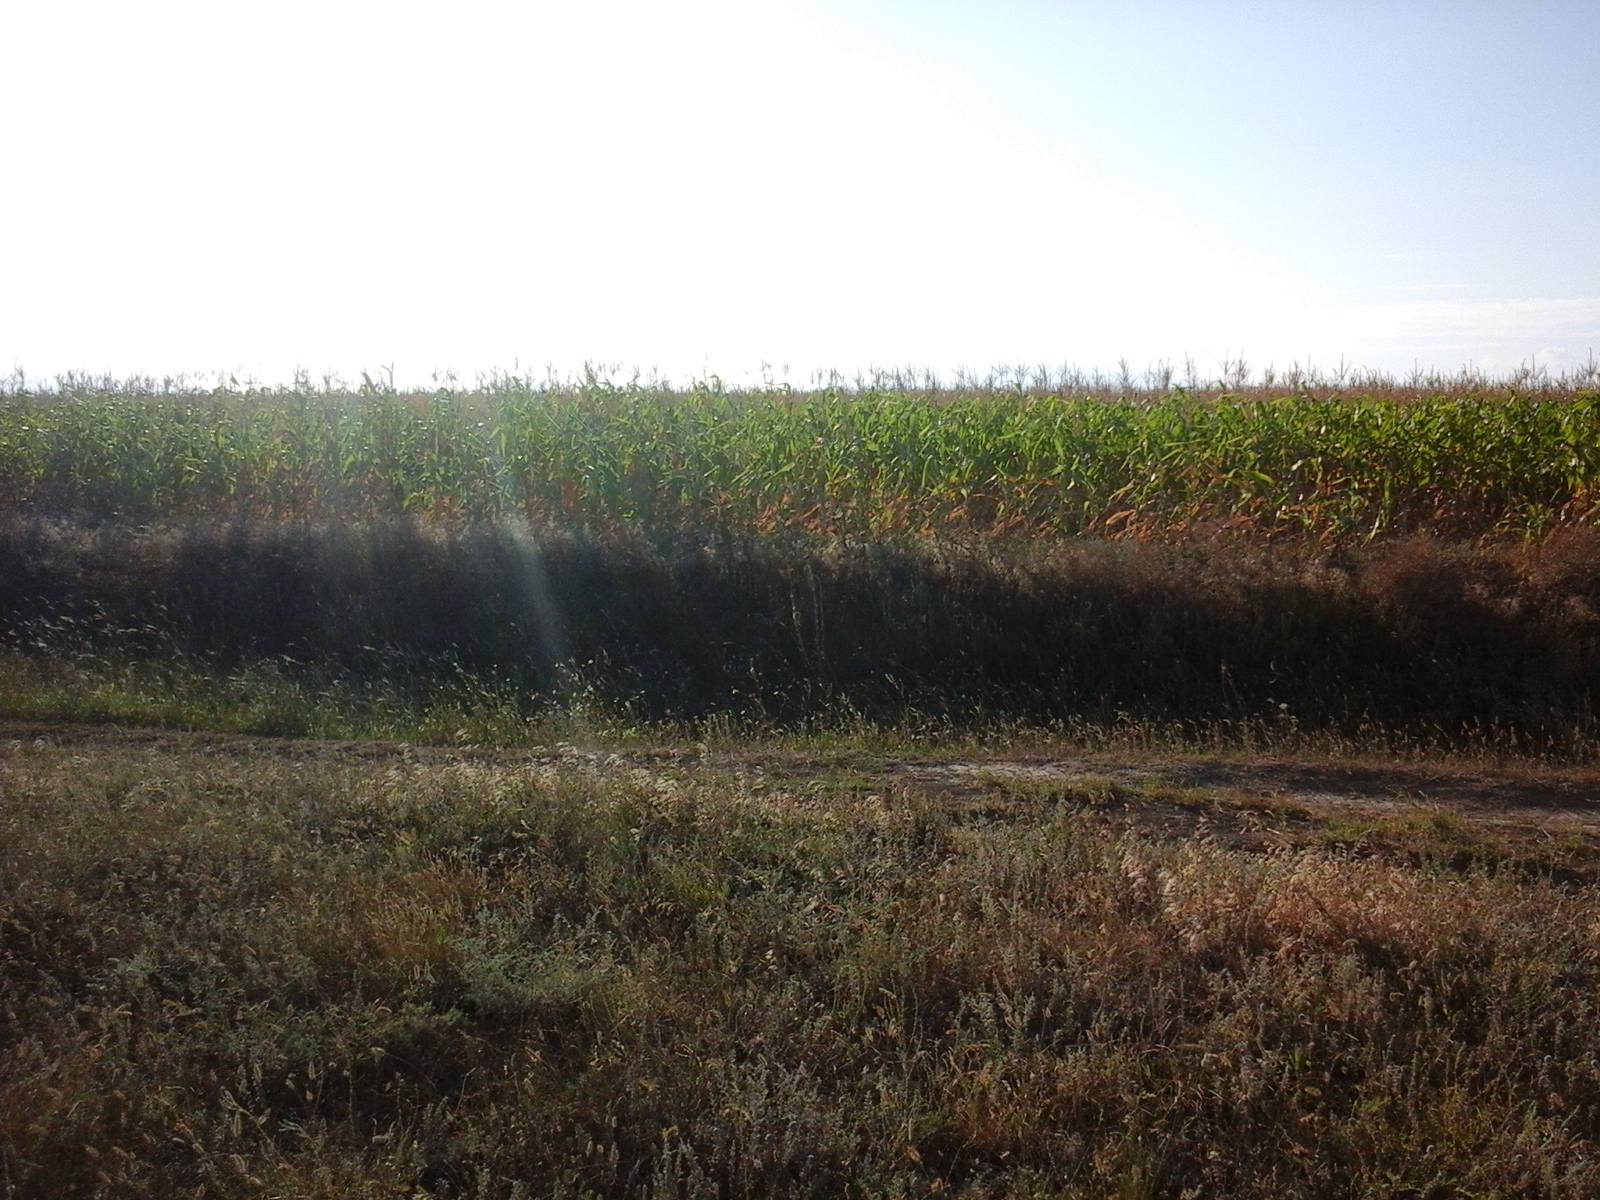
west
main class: Grassland
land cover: Grassland without tree/shrub cover
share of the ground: > 75 %
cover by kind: herbaceous plants 100 %
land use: Agriculture (excluding fallow land and kitchen gardens)
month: August
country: RO
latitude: 44.8220
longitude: 28.9479
